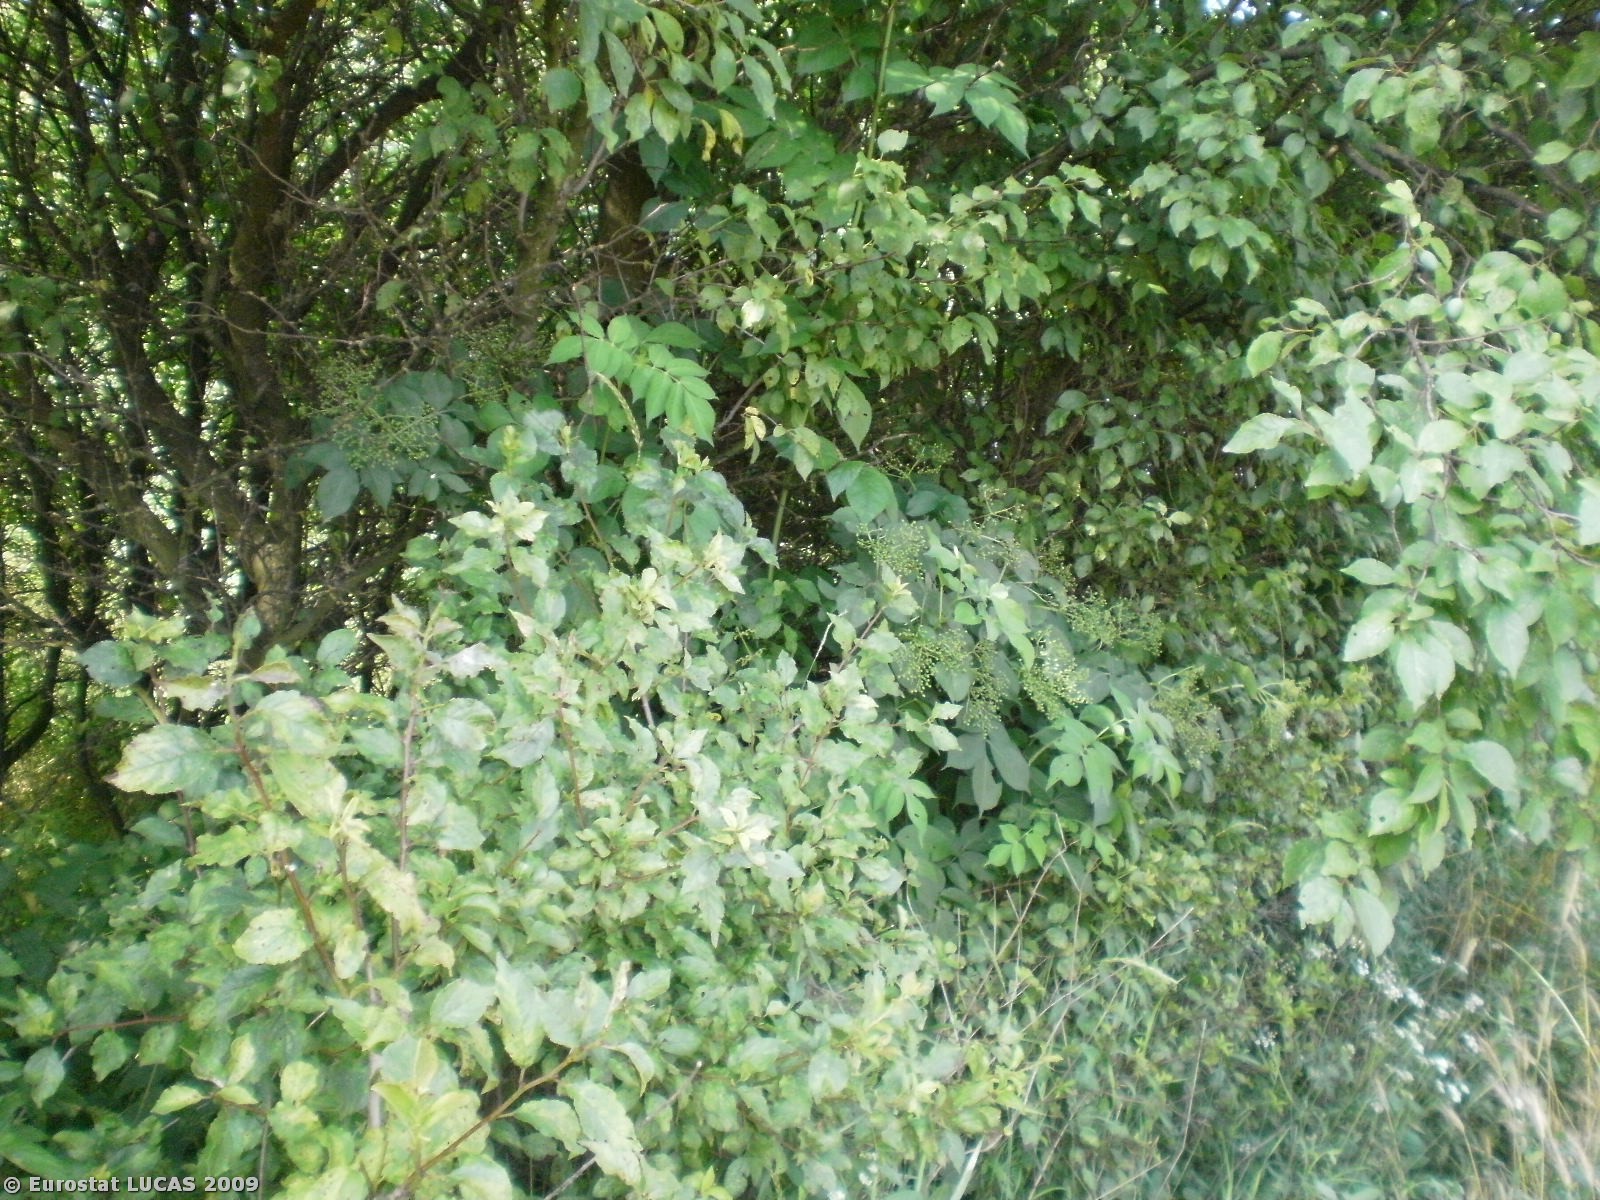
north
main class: Cropland
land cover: Triticale
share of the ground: > 75 %
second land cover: Rye
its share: < 10 %
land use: Agriculture (excluding fallow land and kitchen gardens)
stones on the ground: < 10 %
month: July
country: PL
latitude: 52.7148
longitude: 20.8334
